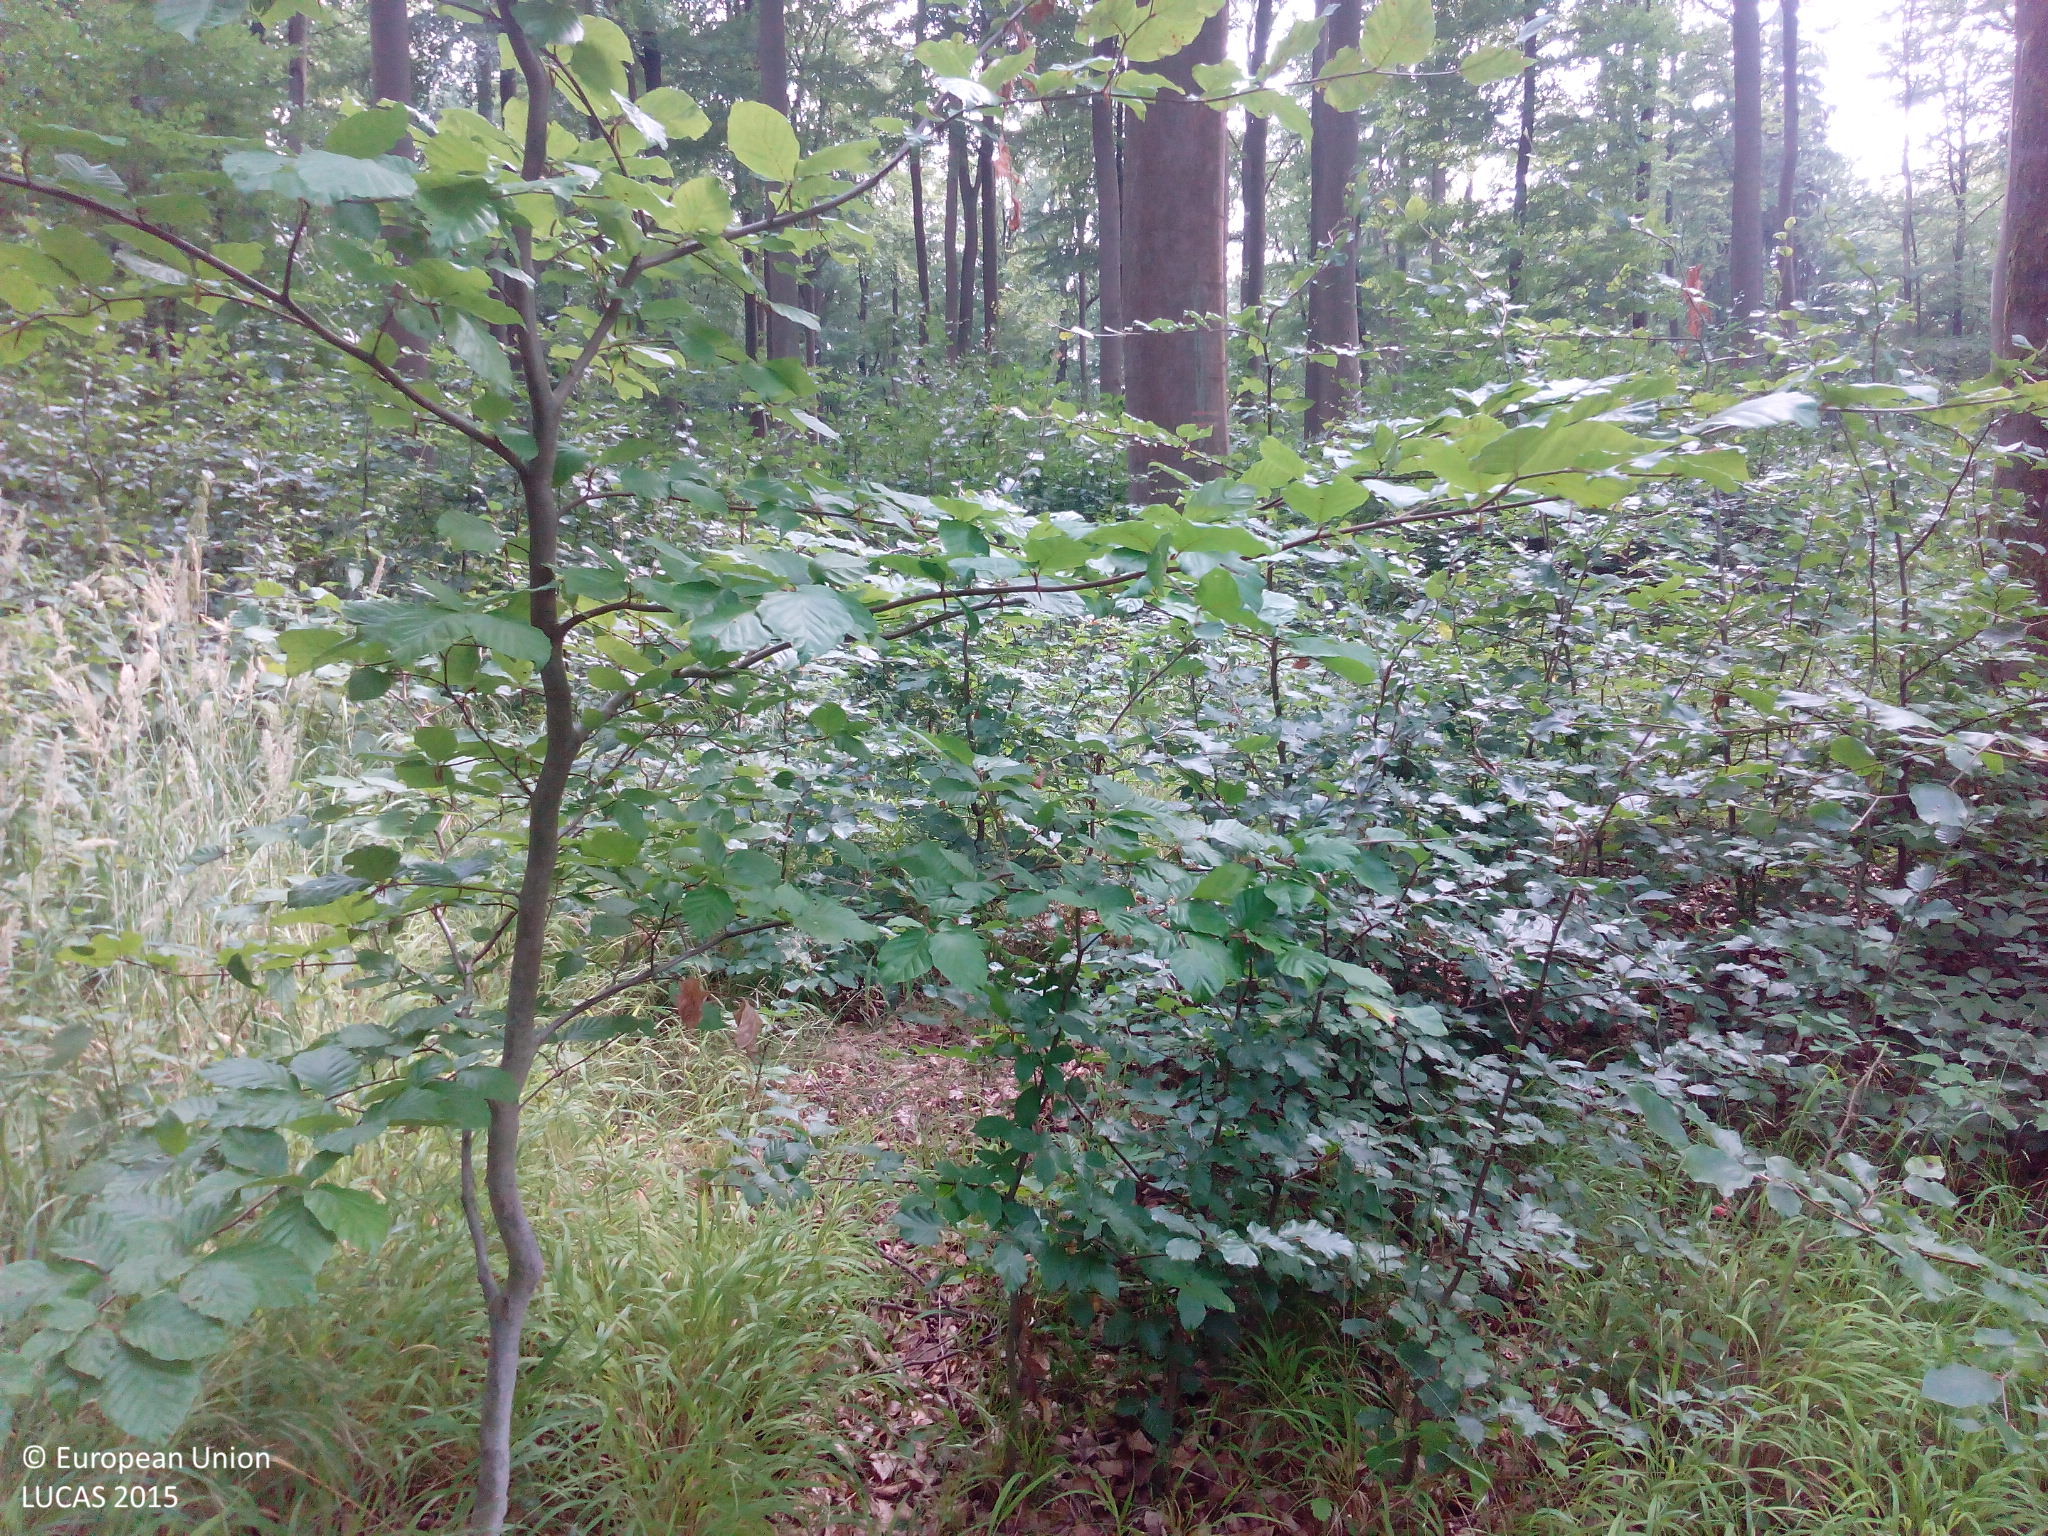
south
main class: Woodland
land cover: Broadleaved woodland
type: beech forest
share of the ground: > 75 %
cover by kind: broadleaved forest trees 70 %, coniferous forest trees 10 %, shrubs 10 %, herbaceous plants 10 %
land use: Forestry
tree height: > 5 m
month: August
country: DE
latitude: 50.2764
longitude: 8.1061
